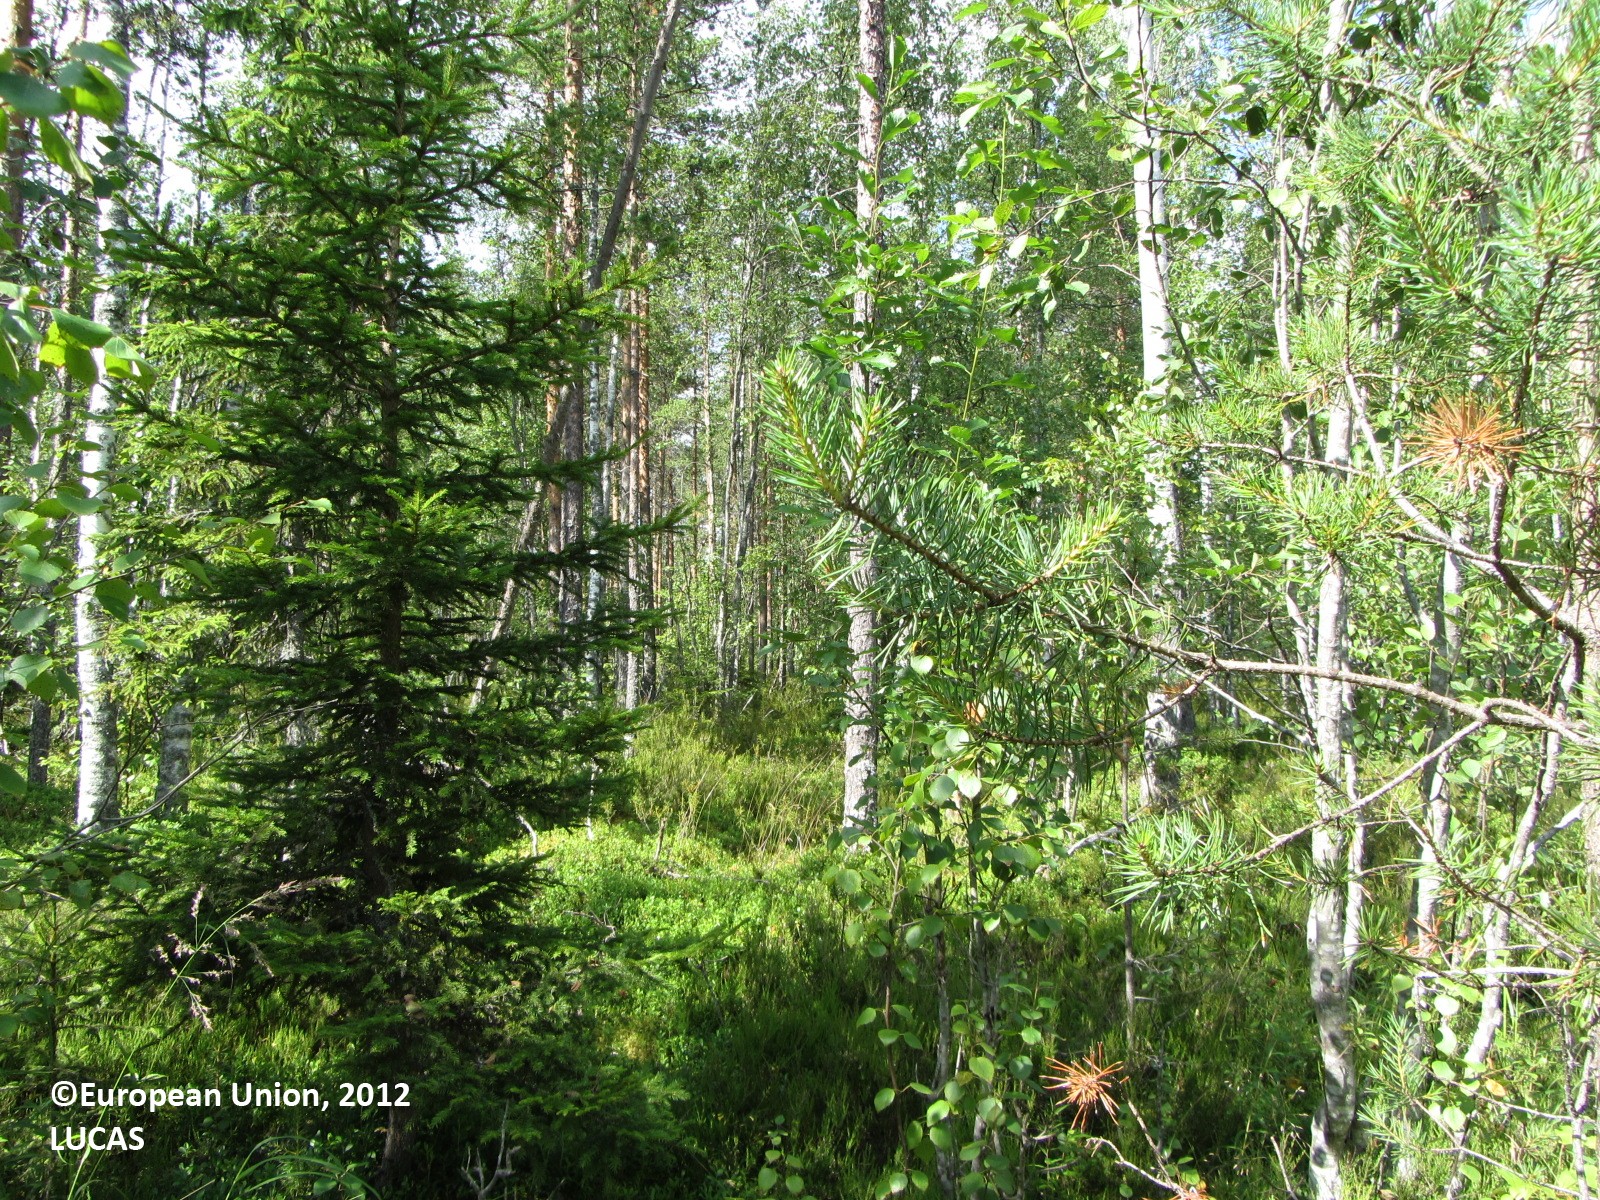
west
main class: Woodland
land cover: Other mixed woodland
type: boreal forest
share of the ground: 50 - 75 %
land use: Forestry
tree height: > 5 m
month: July
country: FI
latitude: 63.6797
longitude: 24.6148
